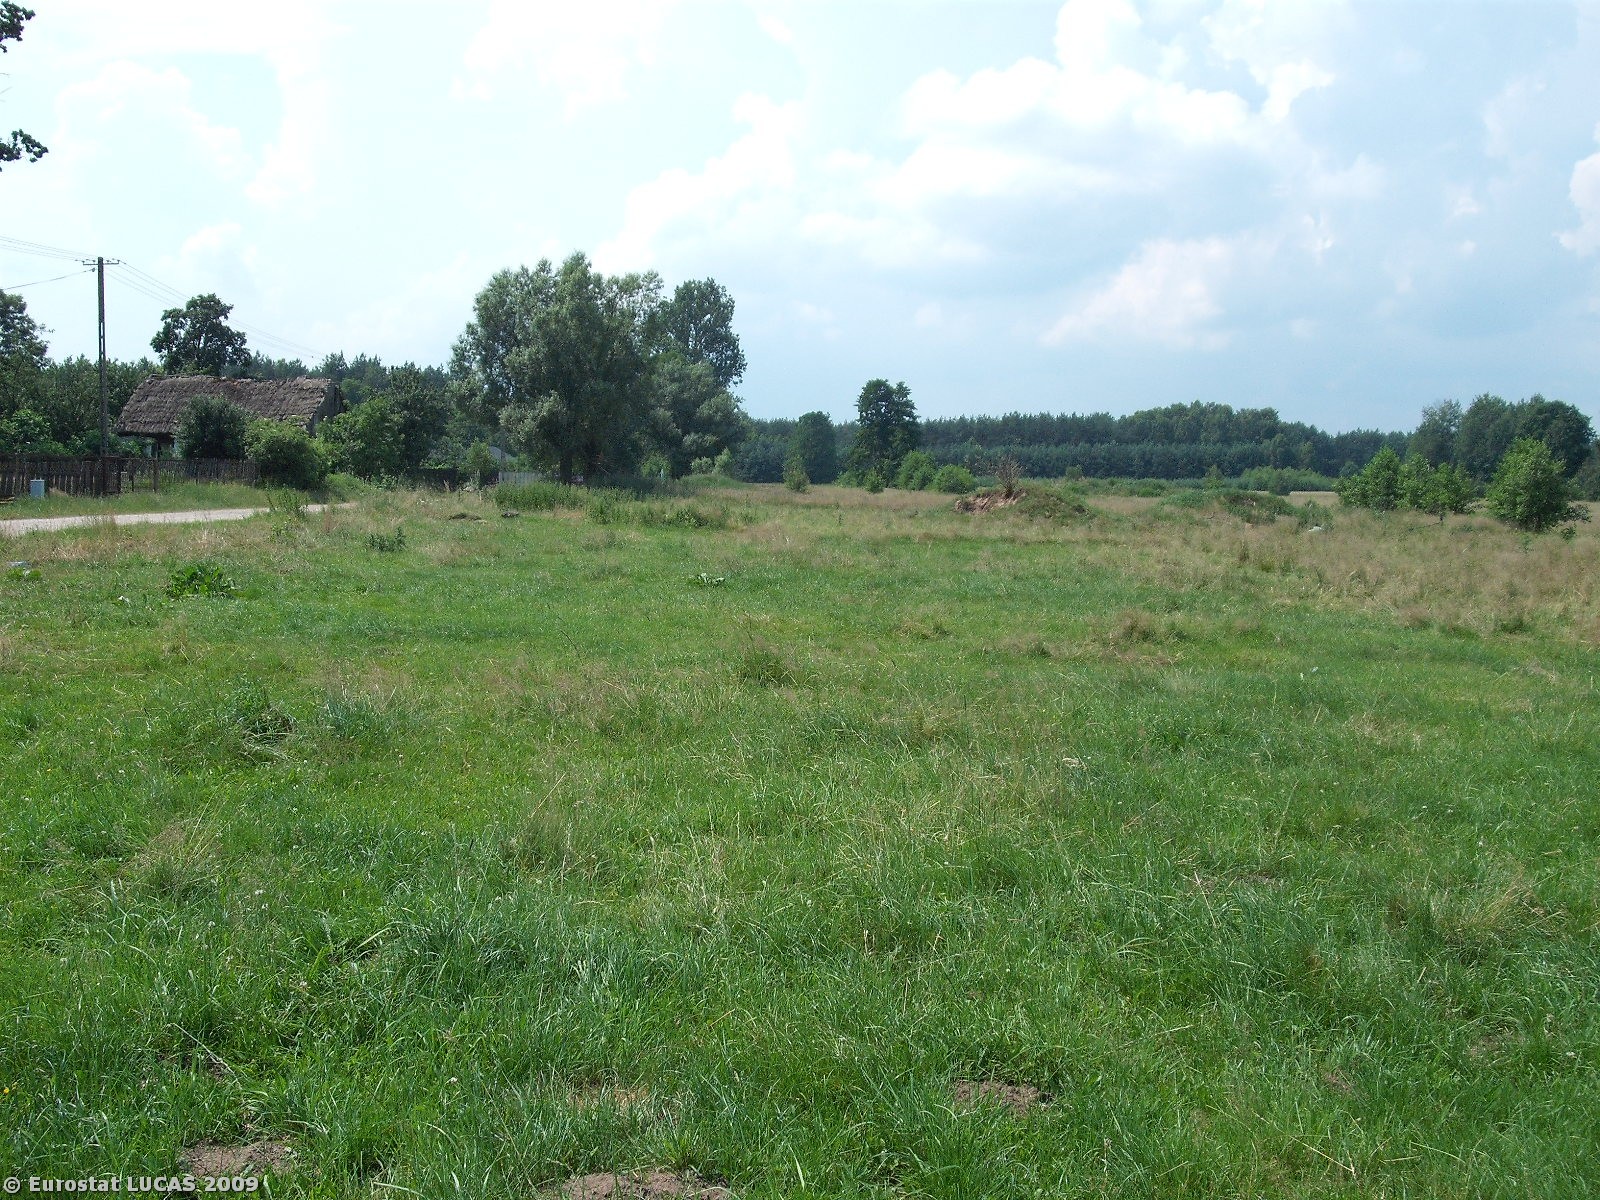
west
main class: Grassland
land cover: Grassland without tree/shrub cover
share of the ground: > 75 %
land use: Agriculture (excluding fallow land and kitchen gardens)
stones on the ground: < 10 %
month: July
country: PL
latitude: 51.4847
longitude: 20.5952
